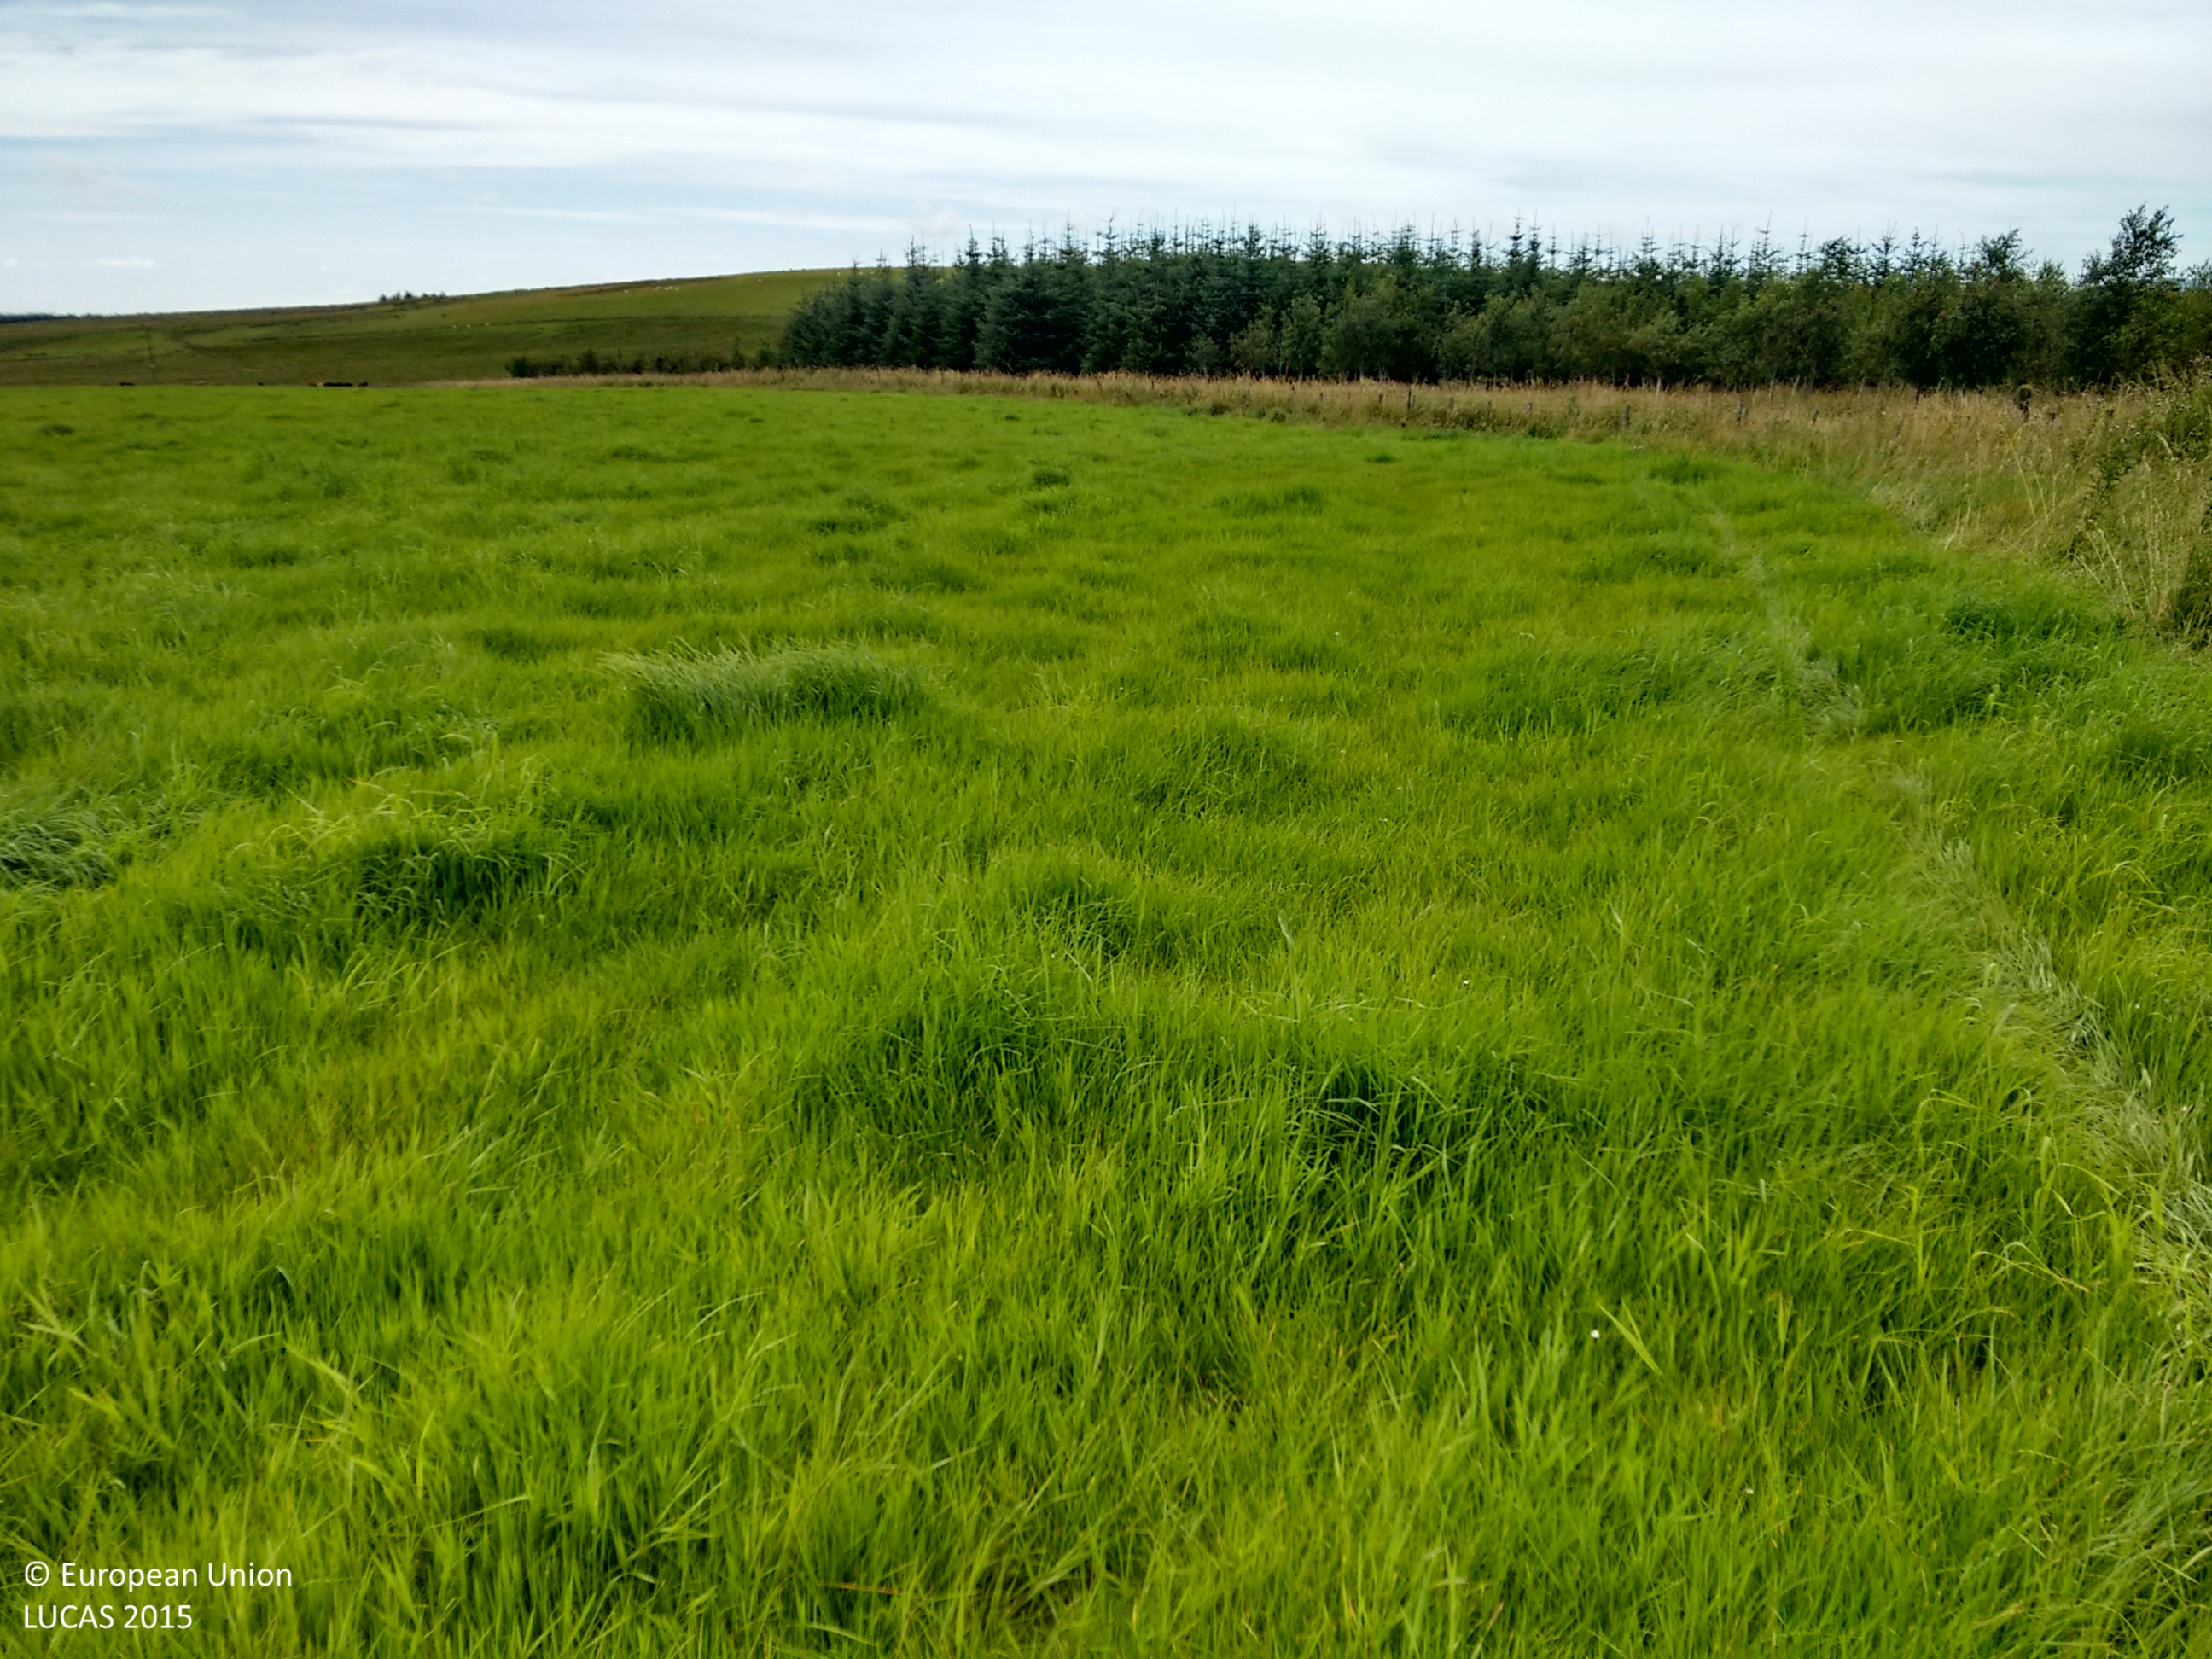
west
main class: Grassland
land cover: Grassland without tree/shrub cover
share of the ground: > 75 %
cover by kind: herbaceous plants 100 %
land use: Agriculture (excluding fallow land and kitchen gardens)
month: August
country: GB
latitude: 55.2291
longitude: -3.3630
